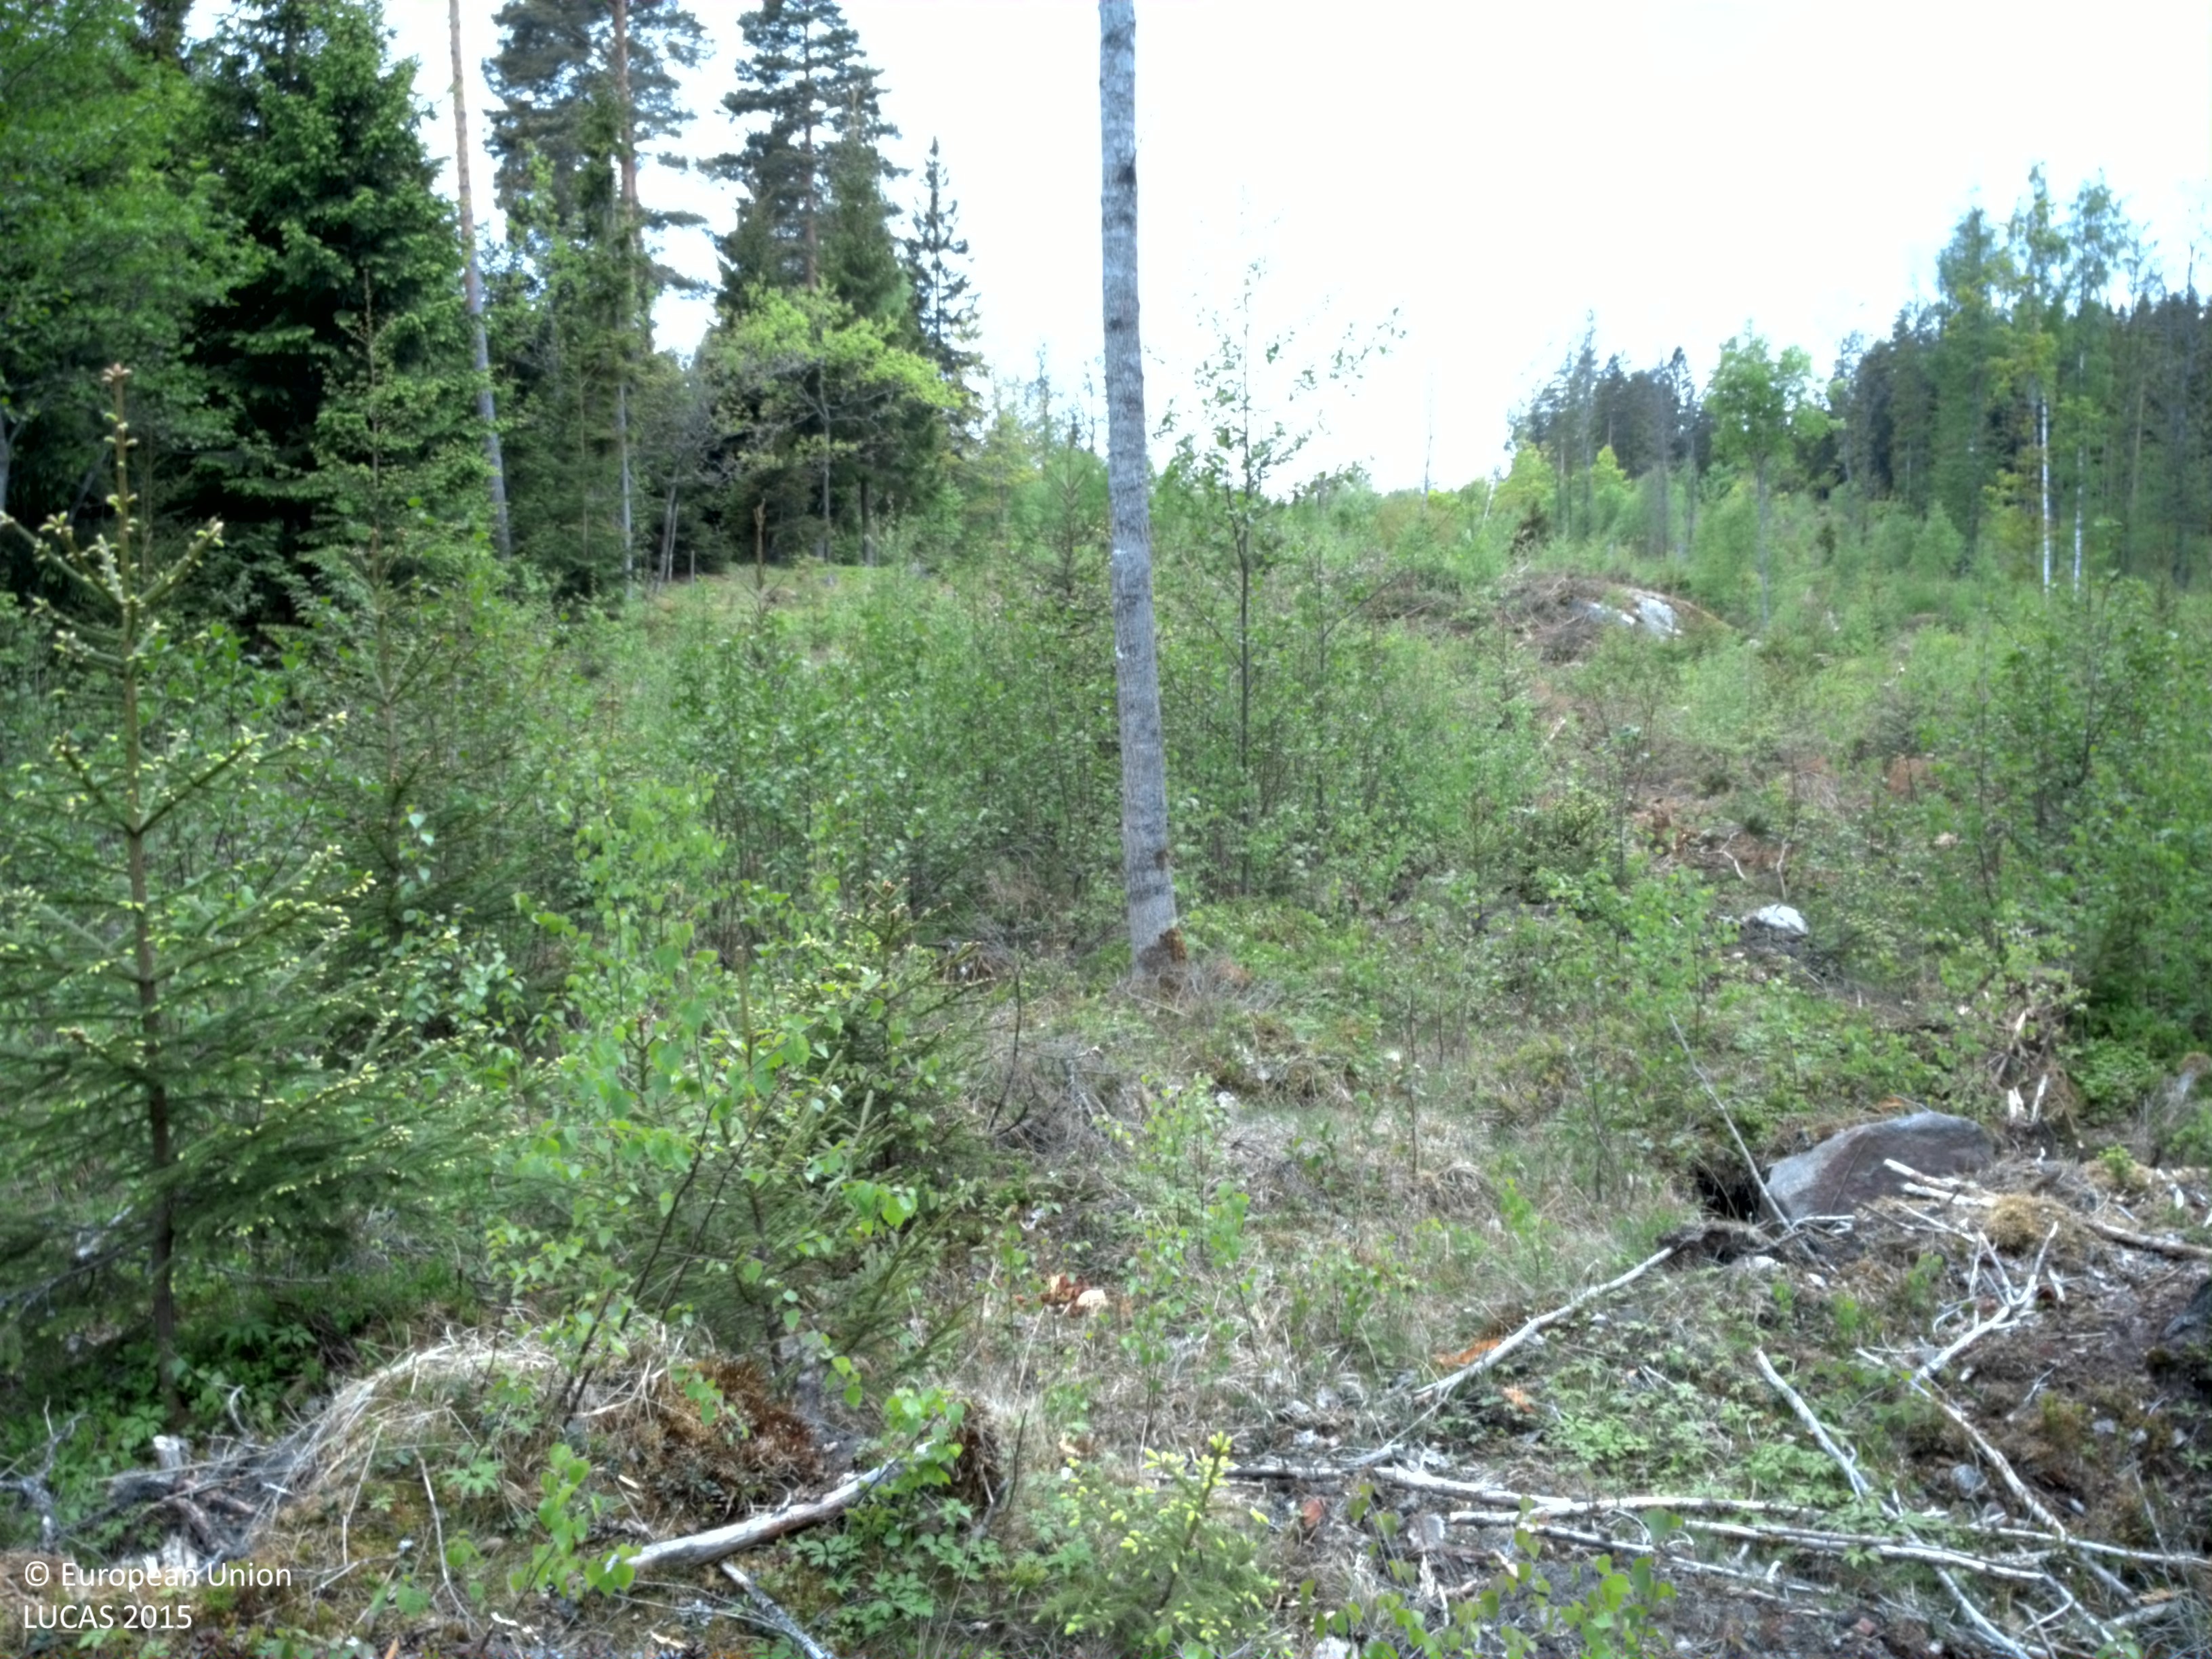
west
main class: Woodland
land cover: Spruce dominated mixed woodland
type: boreal forest
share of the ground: 50 - 75 %
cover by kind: broadleaved forest trees 35 %, coniferous forest trees 25 %, shrubs 15 %, herbaceous plants 15 %, lichens and mosses 10 %
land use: Forestry
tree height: < 5 m
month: May
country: SE
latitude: 57.3815
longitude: 15.6027
